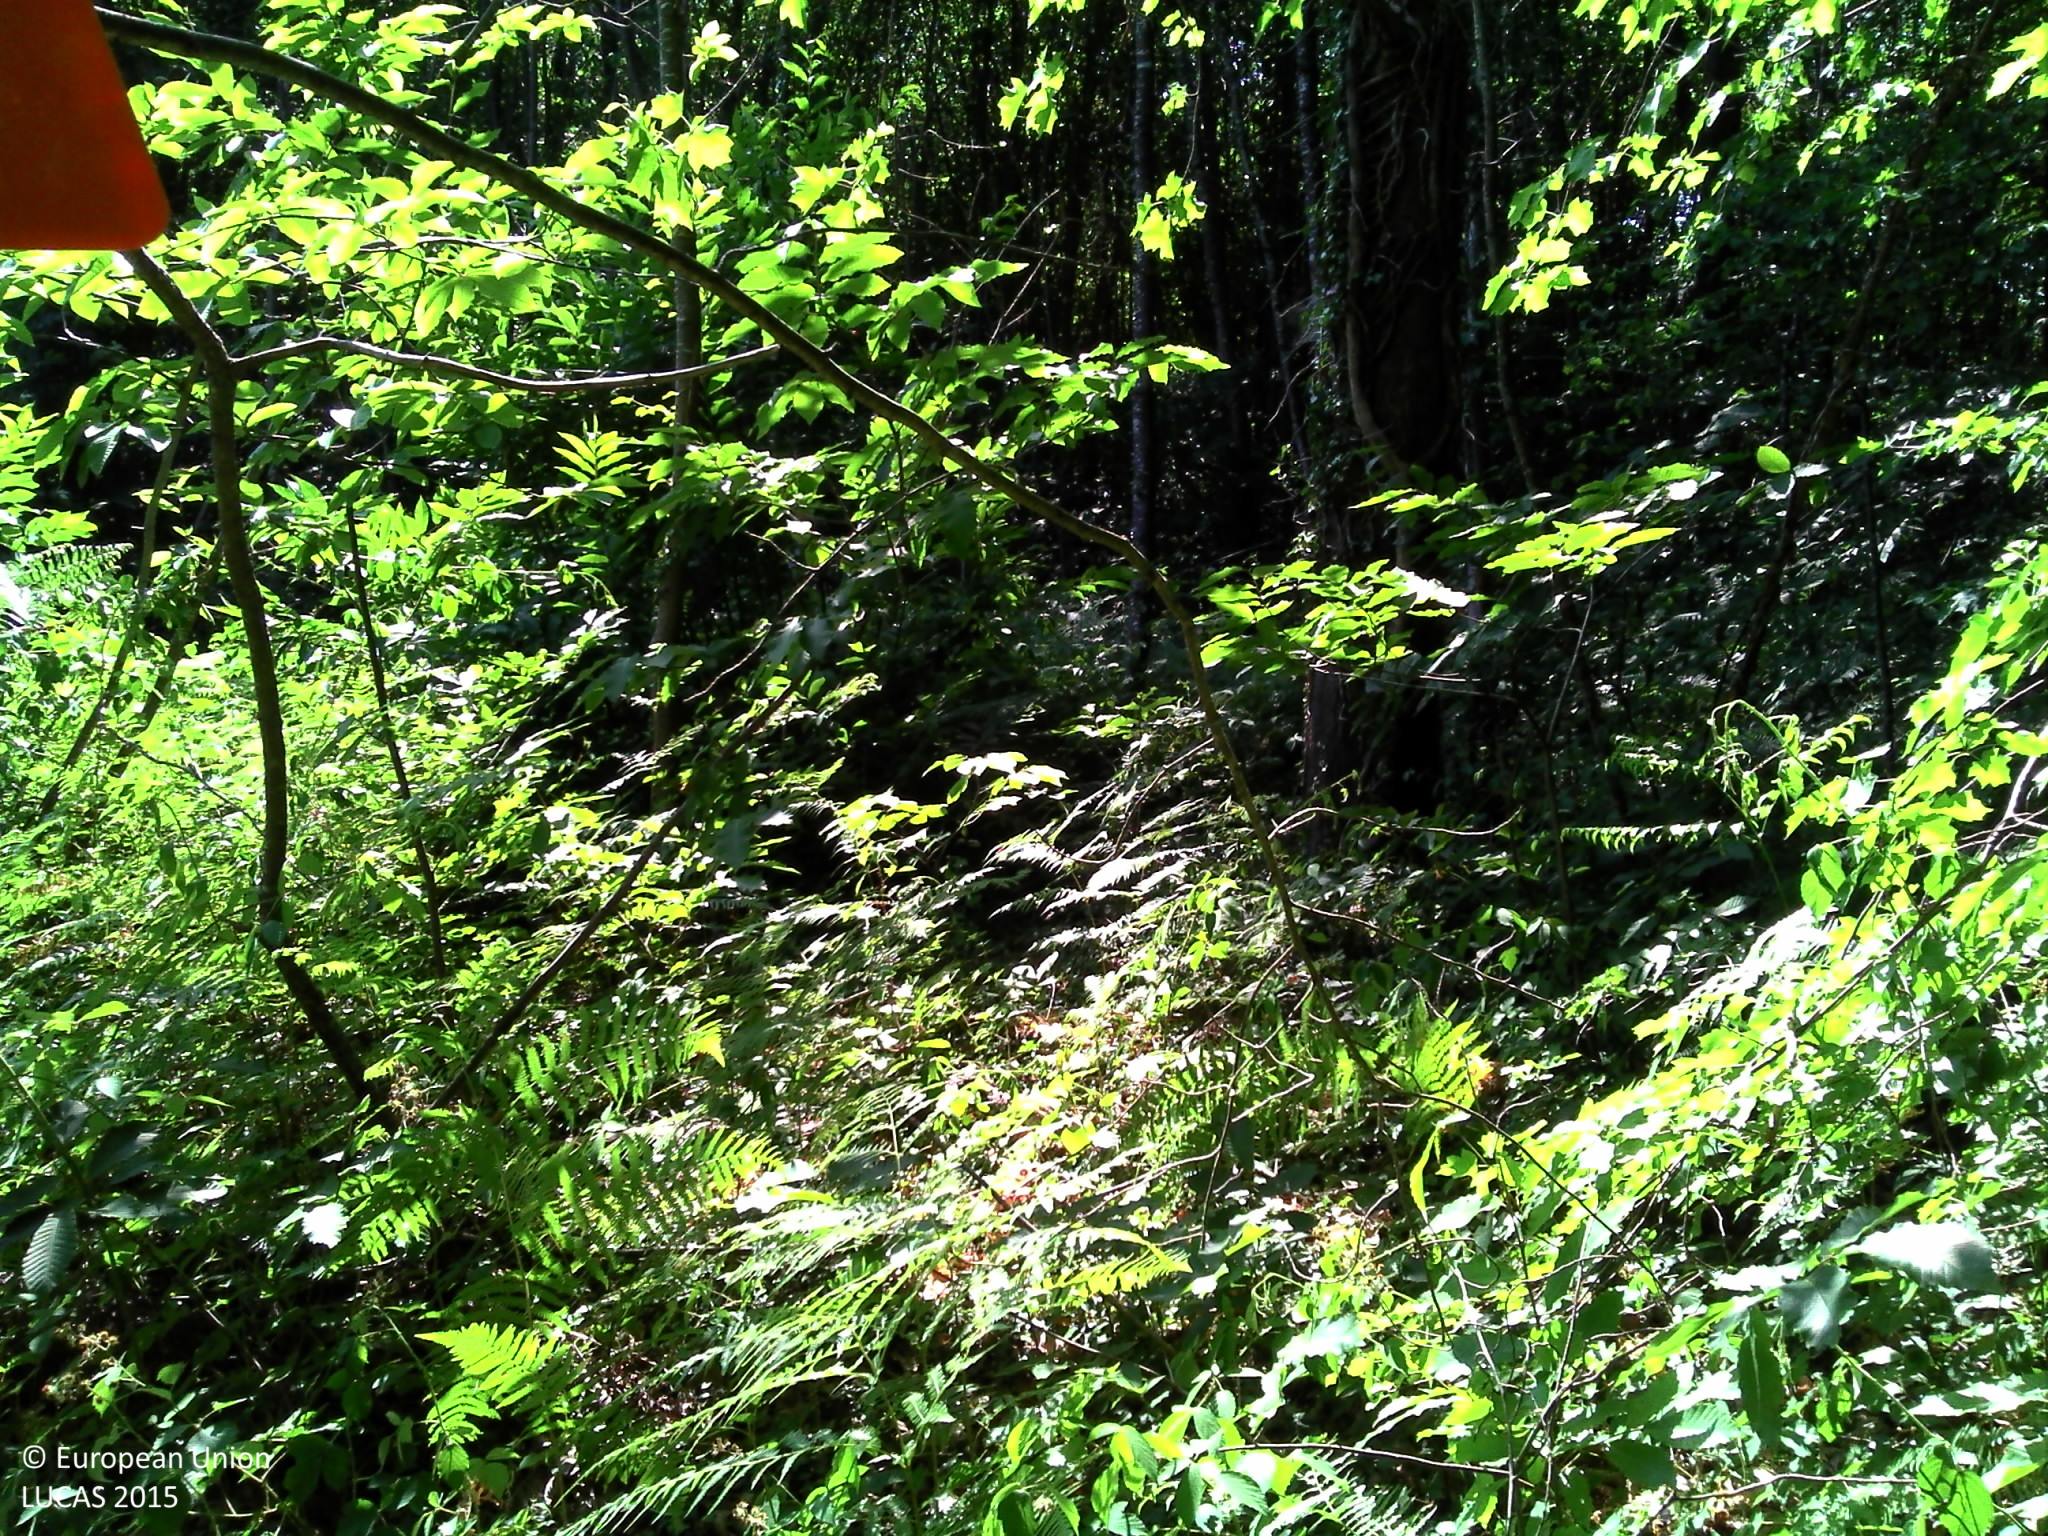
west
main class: Woodland
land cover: Broadleaved woodland
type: mesophytic deciduous forest
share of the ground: > 75 %
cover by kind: broadleaved forest trees 85 %, herbaceous plants 10 %, shrubs 5 %
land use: Forestry
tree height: > 5 m
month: June
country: FR
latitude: 45.5883
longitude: 0.3594
